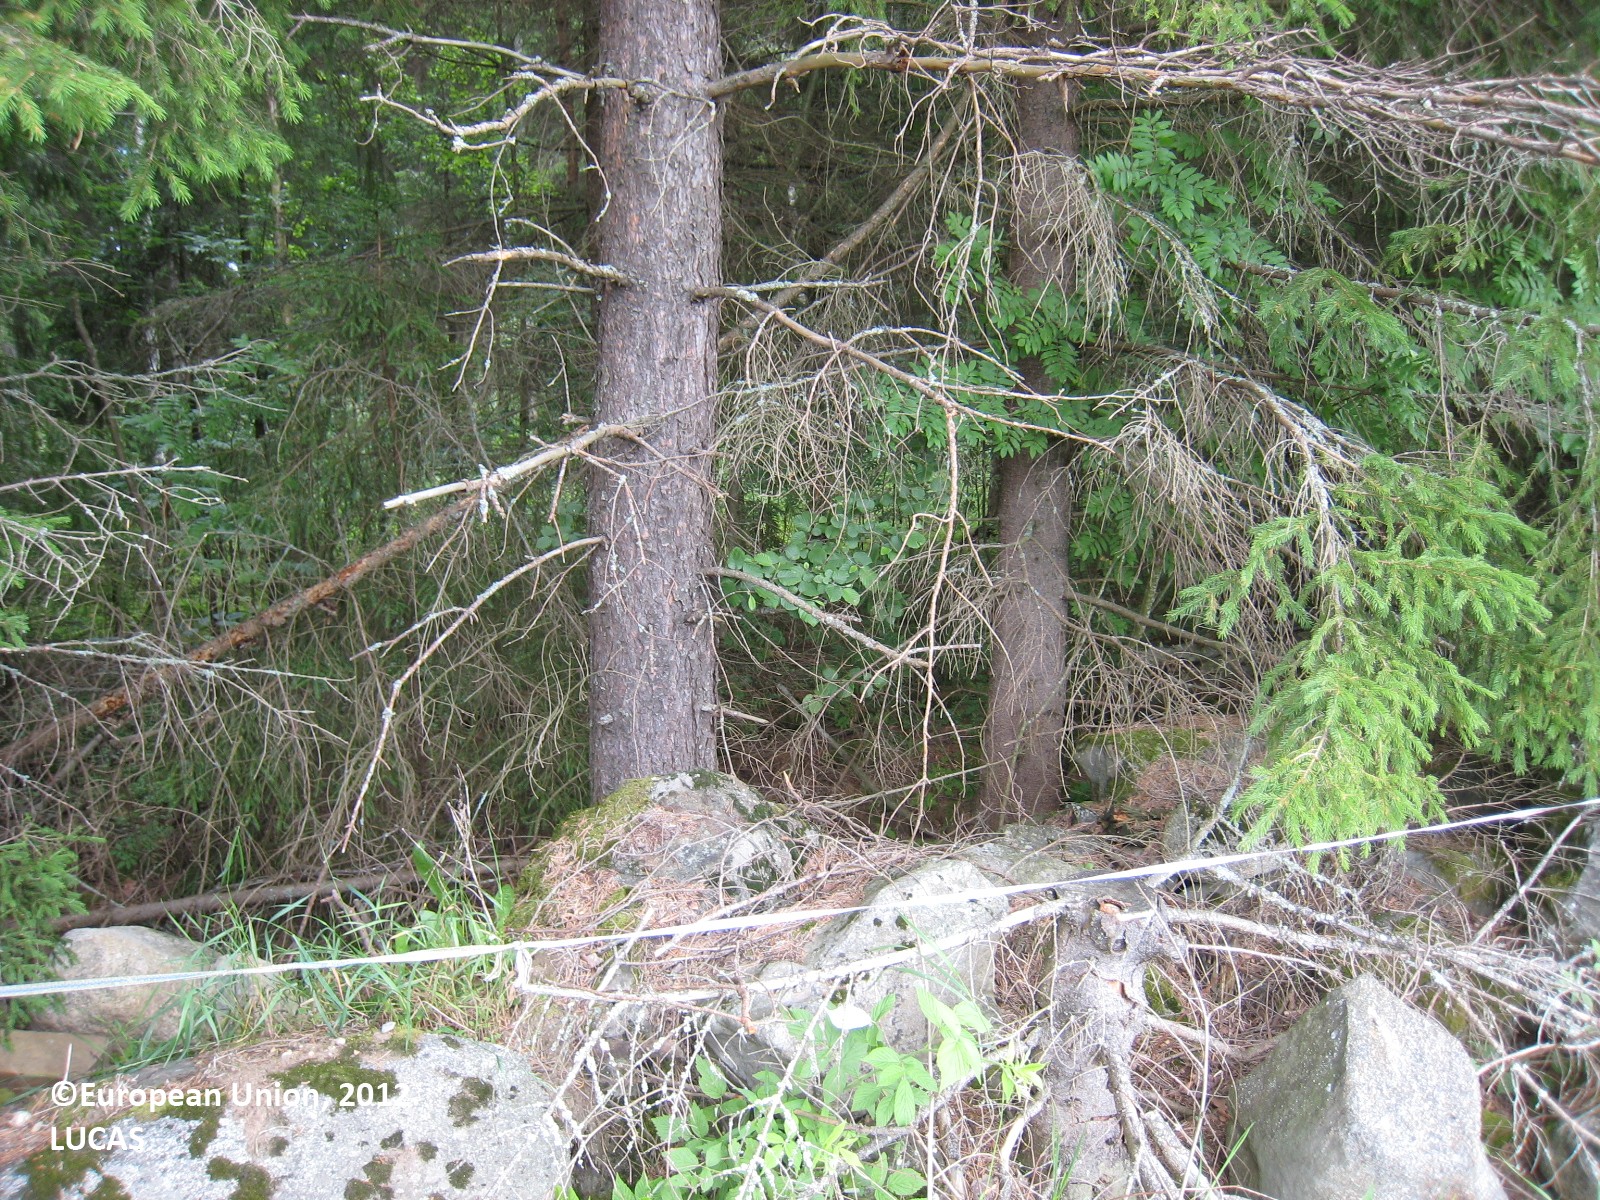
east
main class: Woodland
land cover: Other mixed woodland
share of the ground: > 75 %
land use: Semi-natural and natural areas not in use
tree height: > 5 m
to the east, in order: Other structural elements; Fences; Dry stone walls; Other mixed woodland; Shrubland with sparse tree cover; Ditches and canals; Abandoned hedges; Tracks; Abandoned hedges; Spruce dominated coniferous woodland; Spruce dominated mixed woodland; Ditches and canals; Spruce dominated mixed woodland; Pine dominated mixed woodland; Ditches and canals; Other mixed woodland; Spruce dominated mixed woodland; Other mixed woodland; Pine dominated coniferous woodland
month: July
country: FI
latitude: 61.8677
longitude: 27.0614
